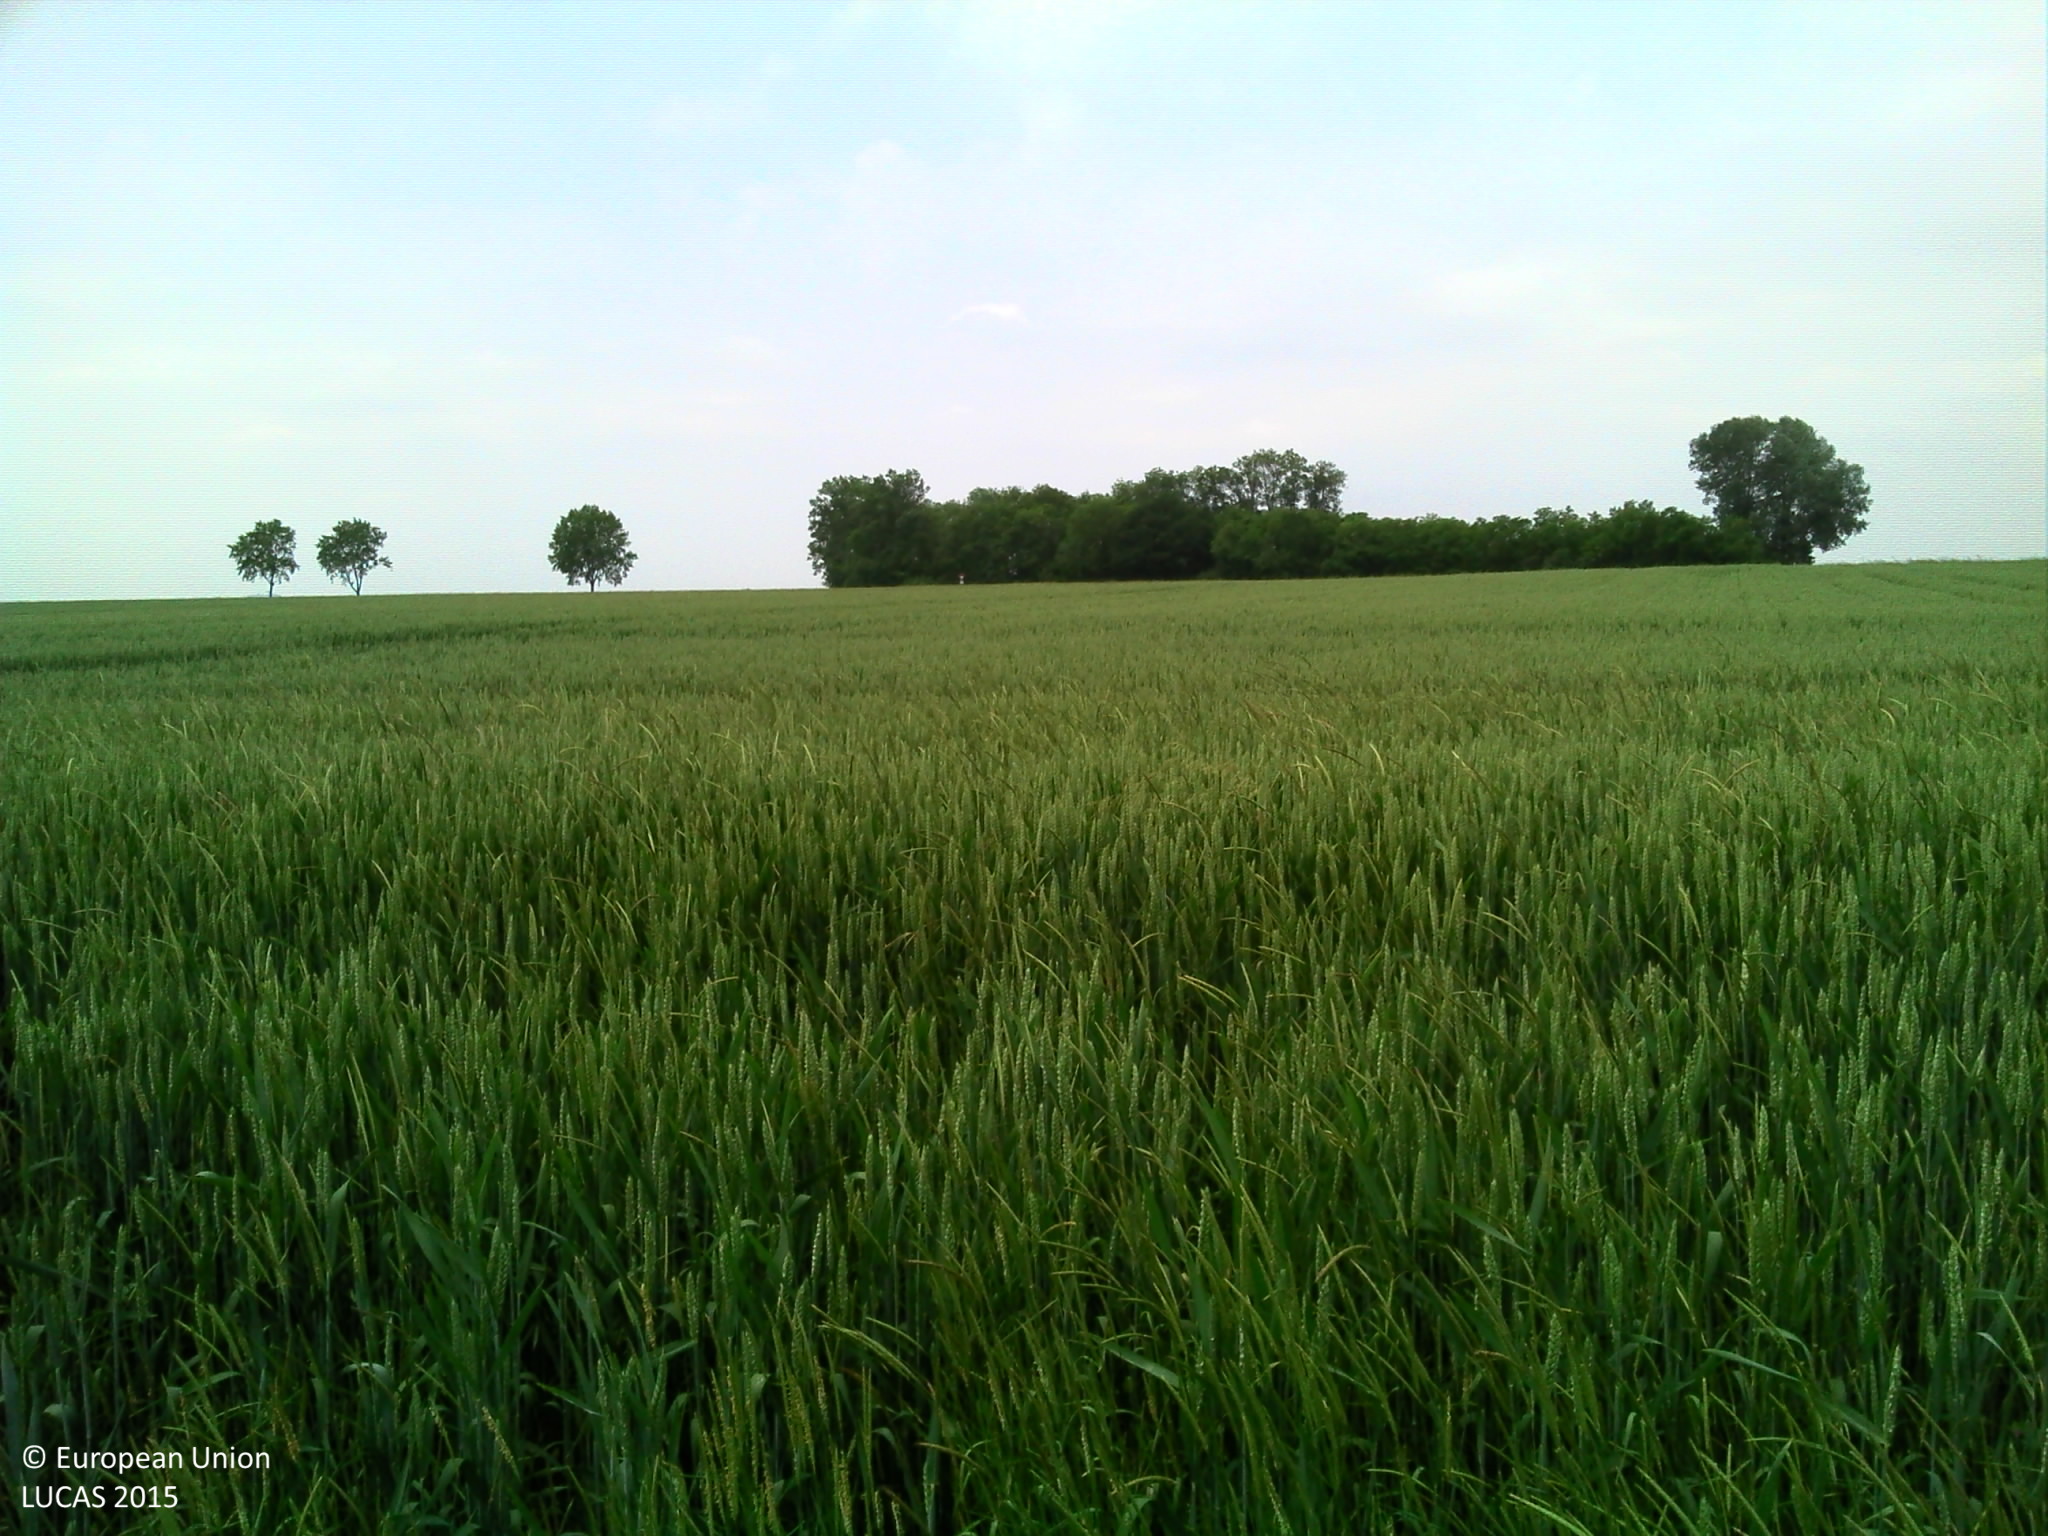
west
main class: Cropland
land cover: Rape and turnip rape
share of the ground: > 75 %
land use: Agriculture (excluding fallow land and kitchen gardens)
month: June
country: FR
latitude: 48.5182
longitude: 6.1958
